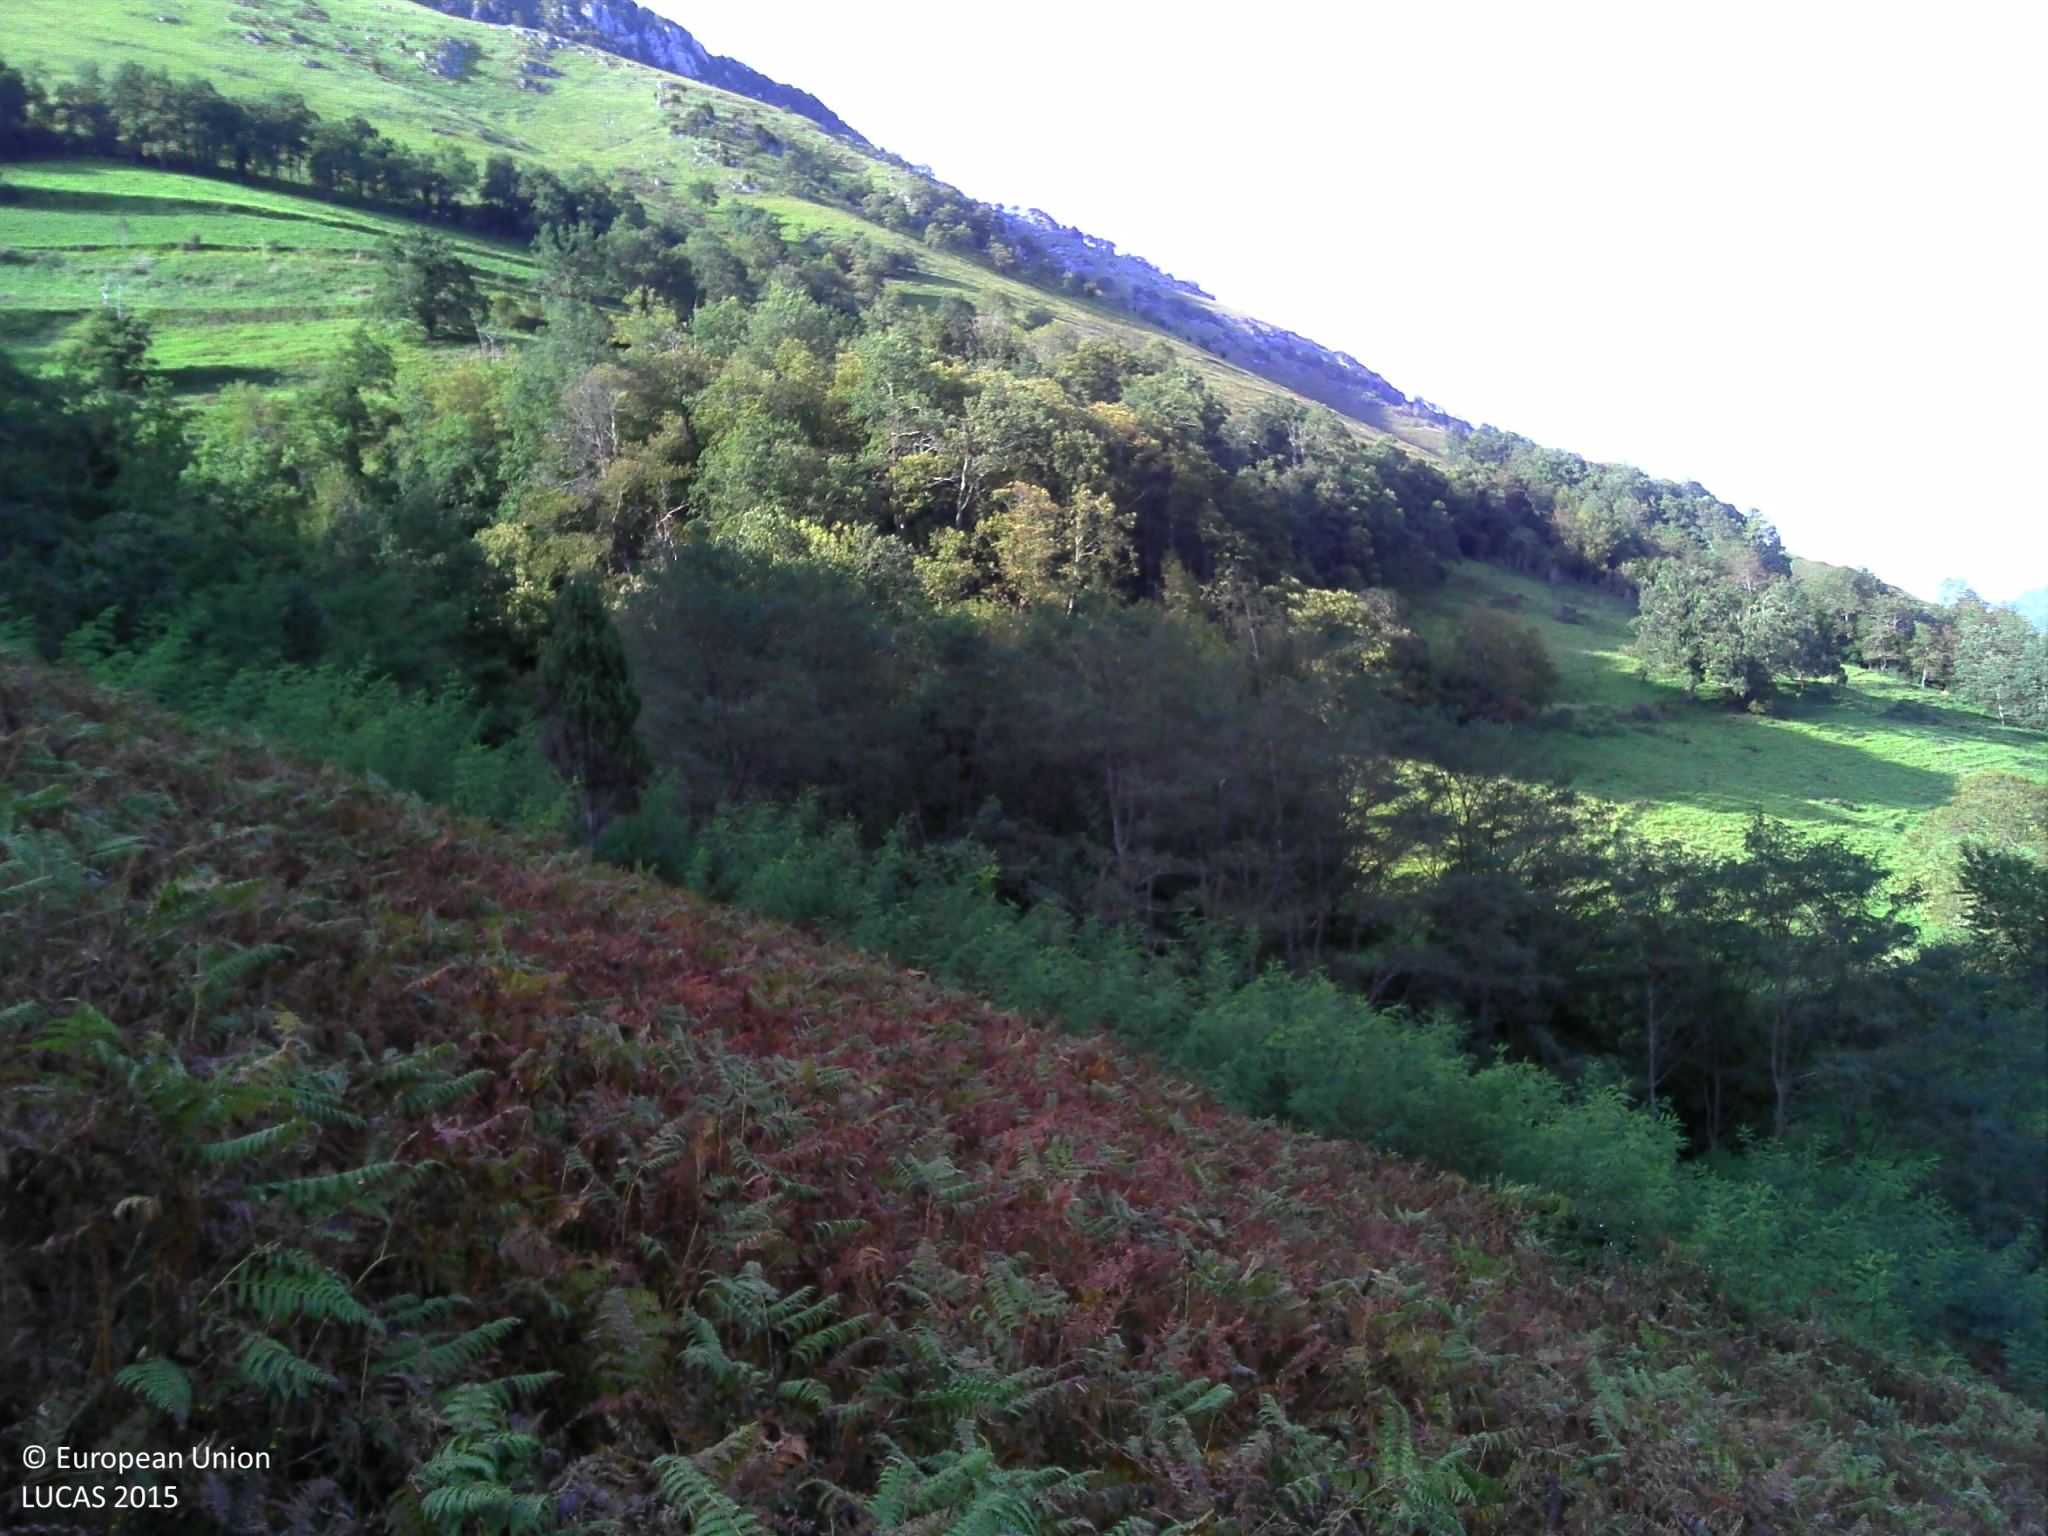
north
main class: Grassland
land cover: Grassland without tree/shrub cover
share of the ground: > 75 %
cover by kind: herbaceous plants 95 %, shrubs 5 %
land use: Agriculture (excluding fallow land and kitchen gardens)
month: September
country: FR
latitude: 43.0041
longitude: -0.6181
